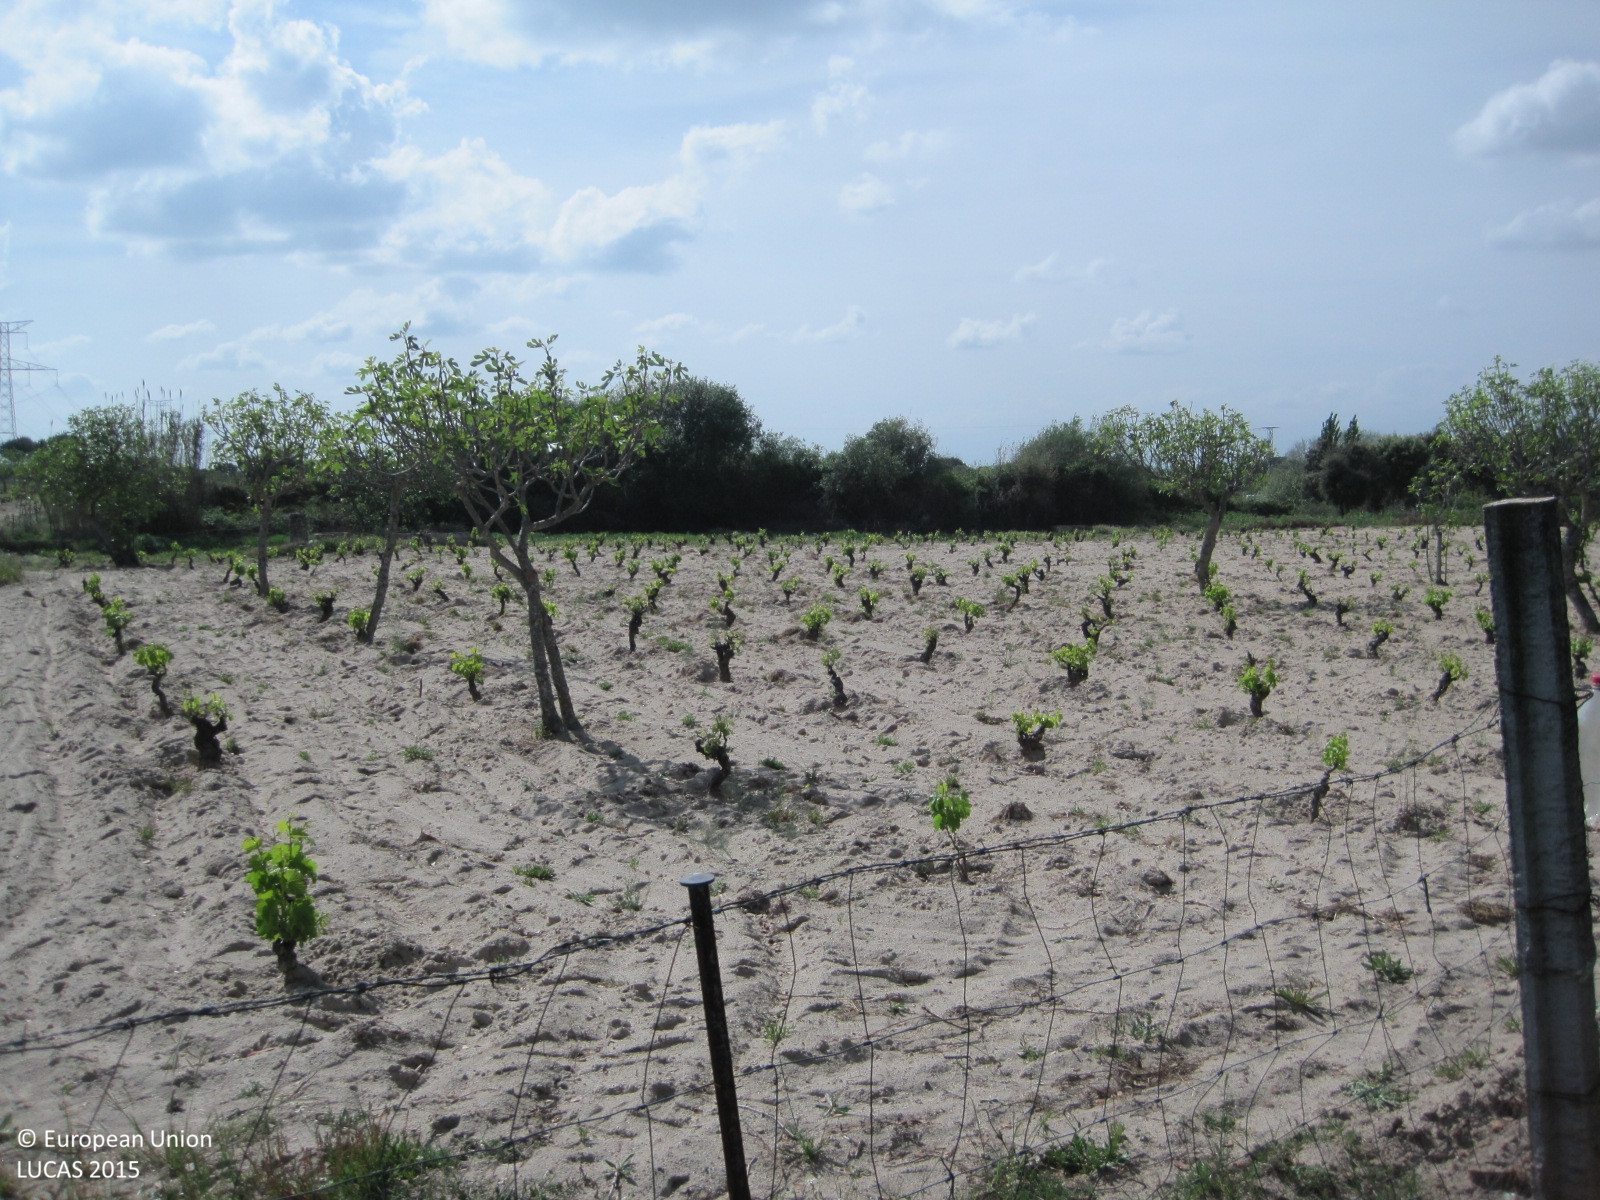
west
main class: Grassland
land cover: Grassland with sparse tree/shrub cover
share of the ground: > 75 %
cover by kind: herbaceous plants 95 %, broadleaved forest trees 5 %
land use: Abandoned areas
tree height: < 5 m
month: April
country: ES
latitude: 40.0157
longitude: -4.9414
